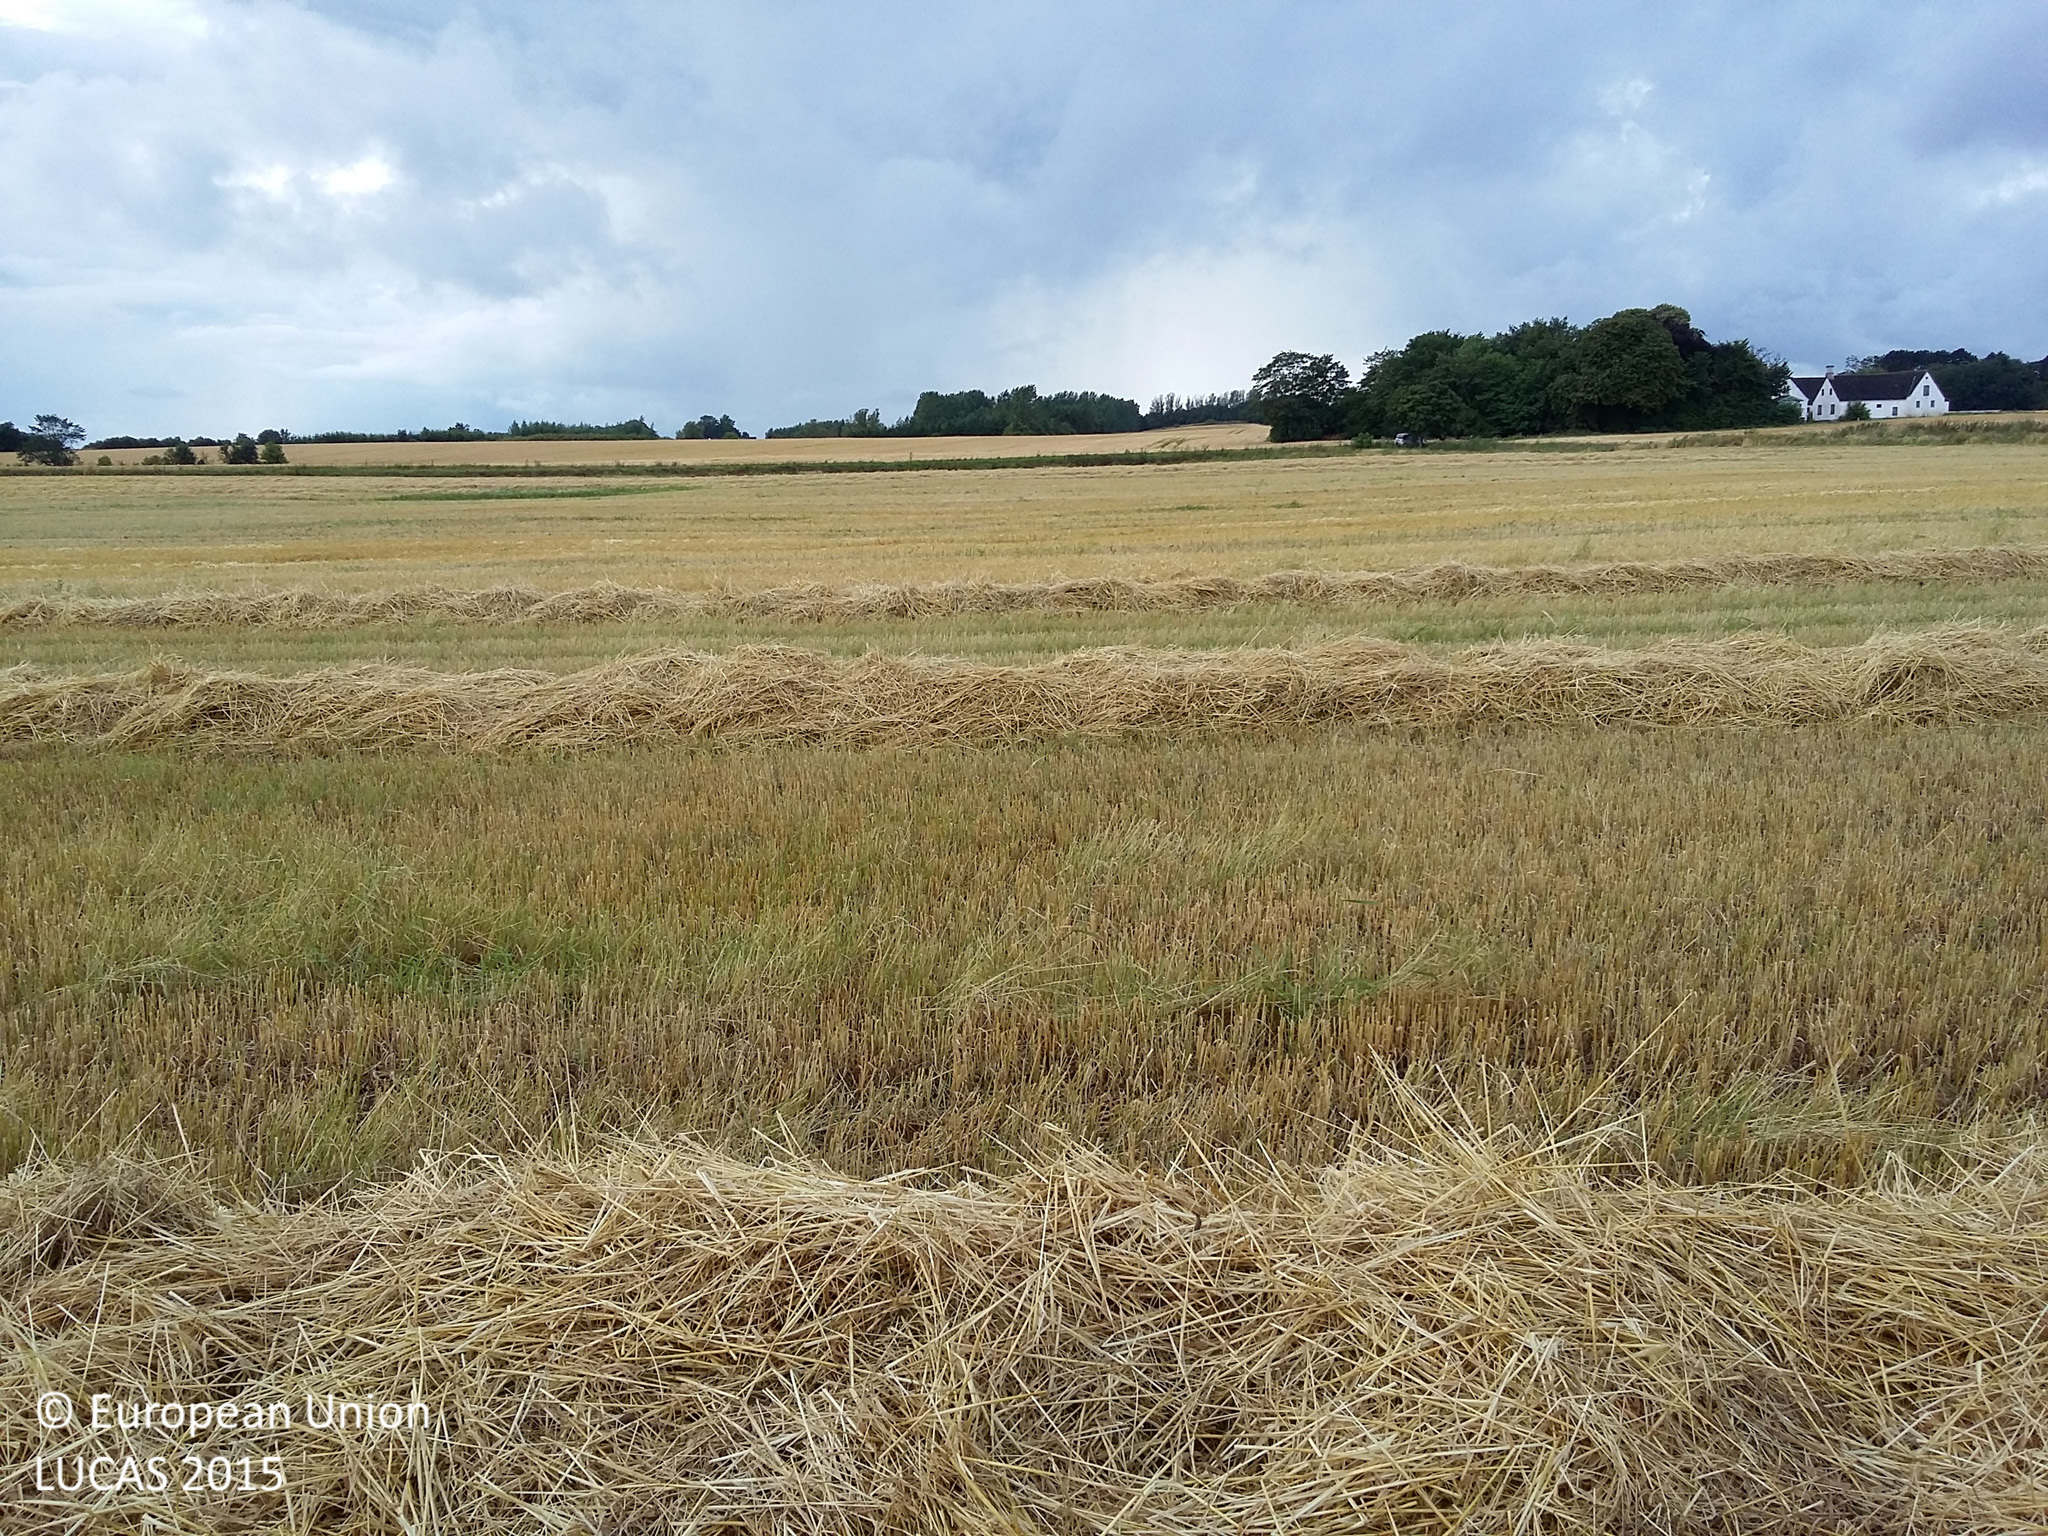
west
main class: Cropland
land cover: Barley
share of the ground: > 75 %
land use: Agriculture (excluding fallow land and kitchen gardens)
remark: Harvested field
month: July
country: DK
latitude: 55.8830
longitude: 12.0923
